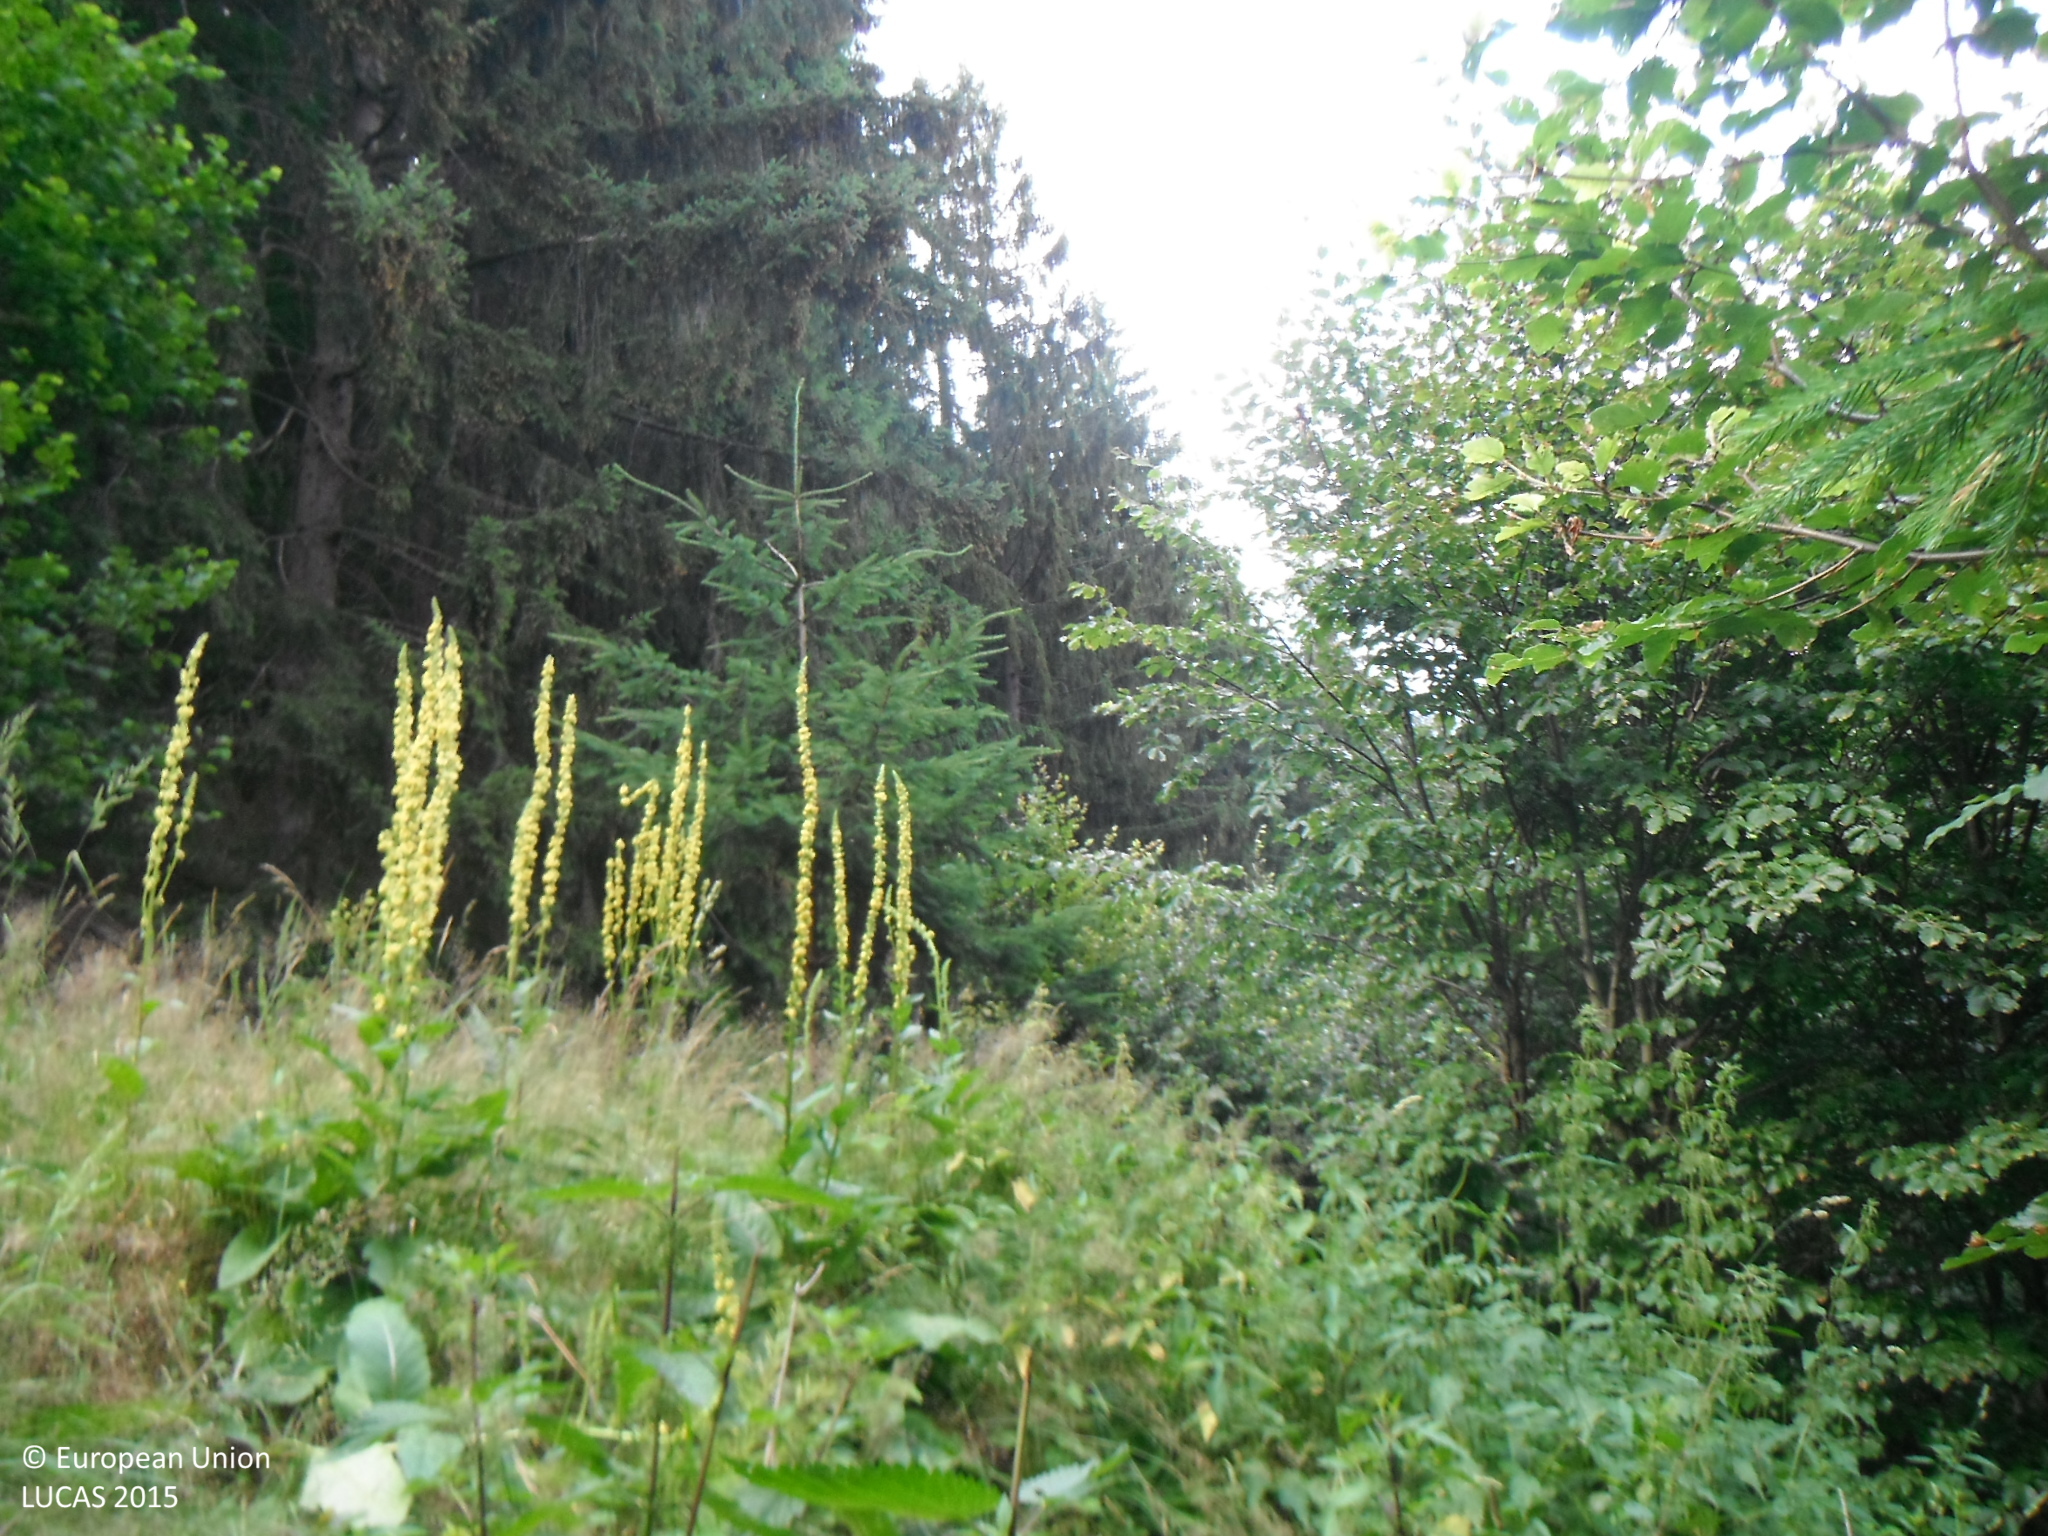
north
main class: Shrubland
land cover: Shrubland with sparse tree cover
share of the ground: > 75 %
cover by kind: shrubs 60 %, herbaceous plants 35 %, coniferous forest trees 5 %
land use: Forestry
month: July
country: SK
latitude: 49.2938
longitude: 18.4189
